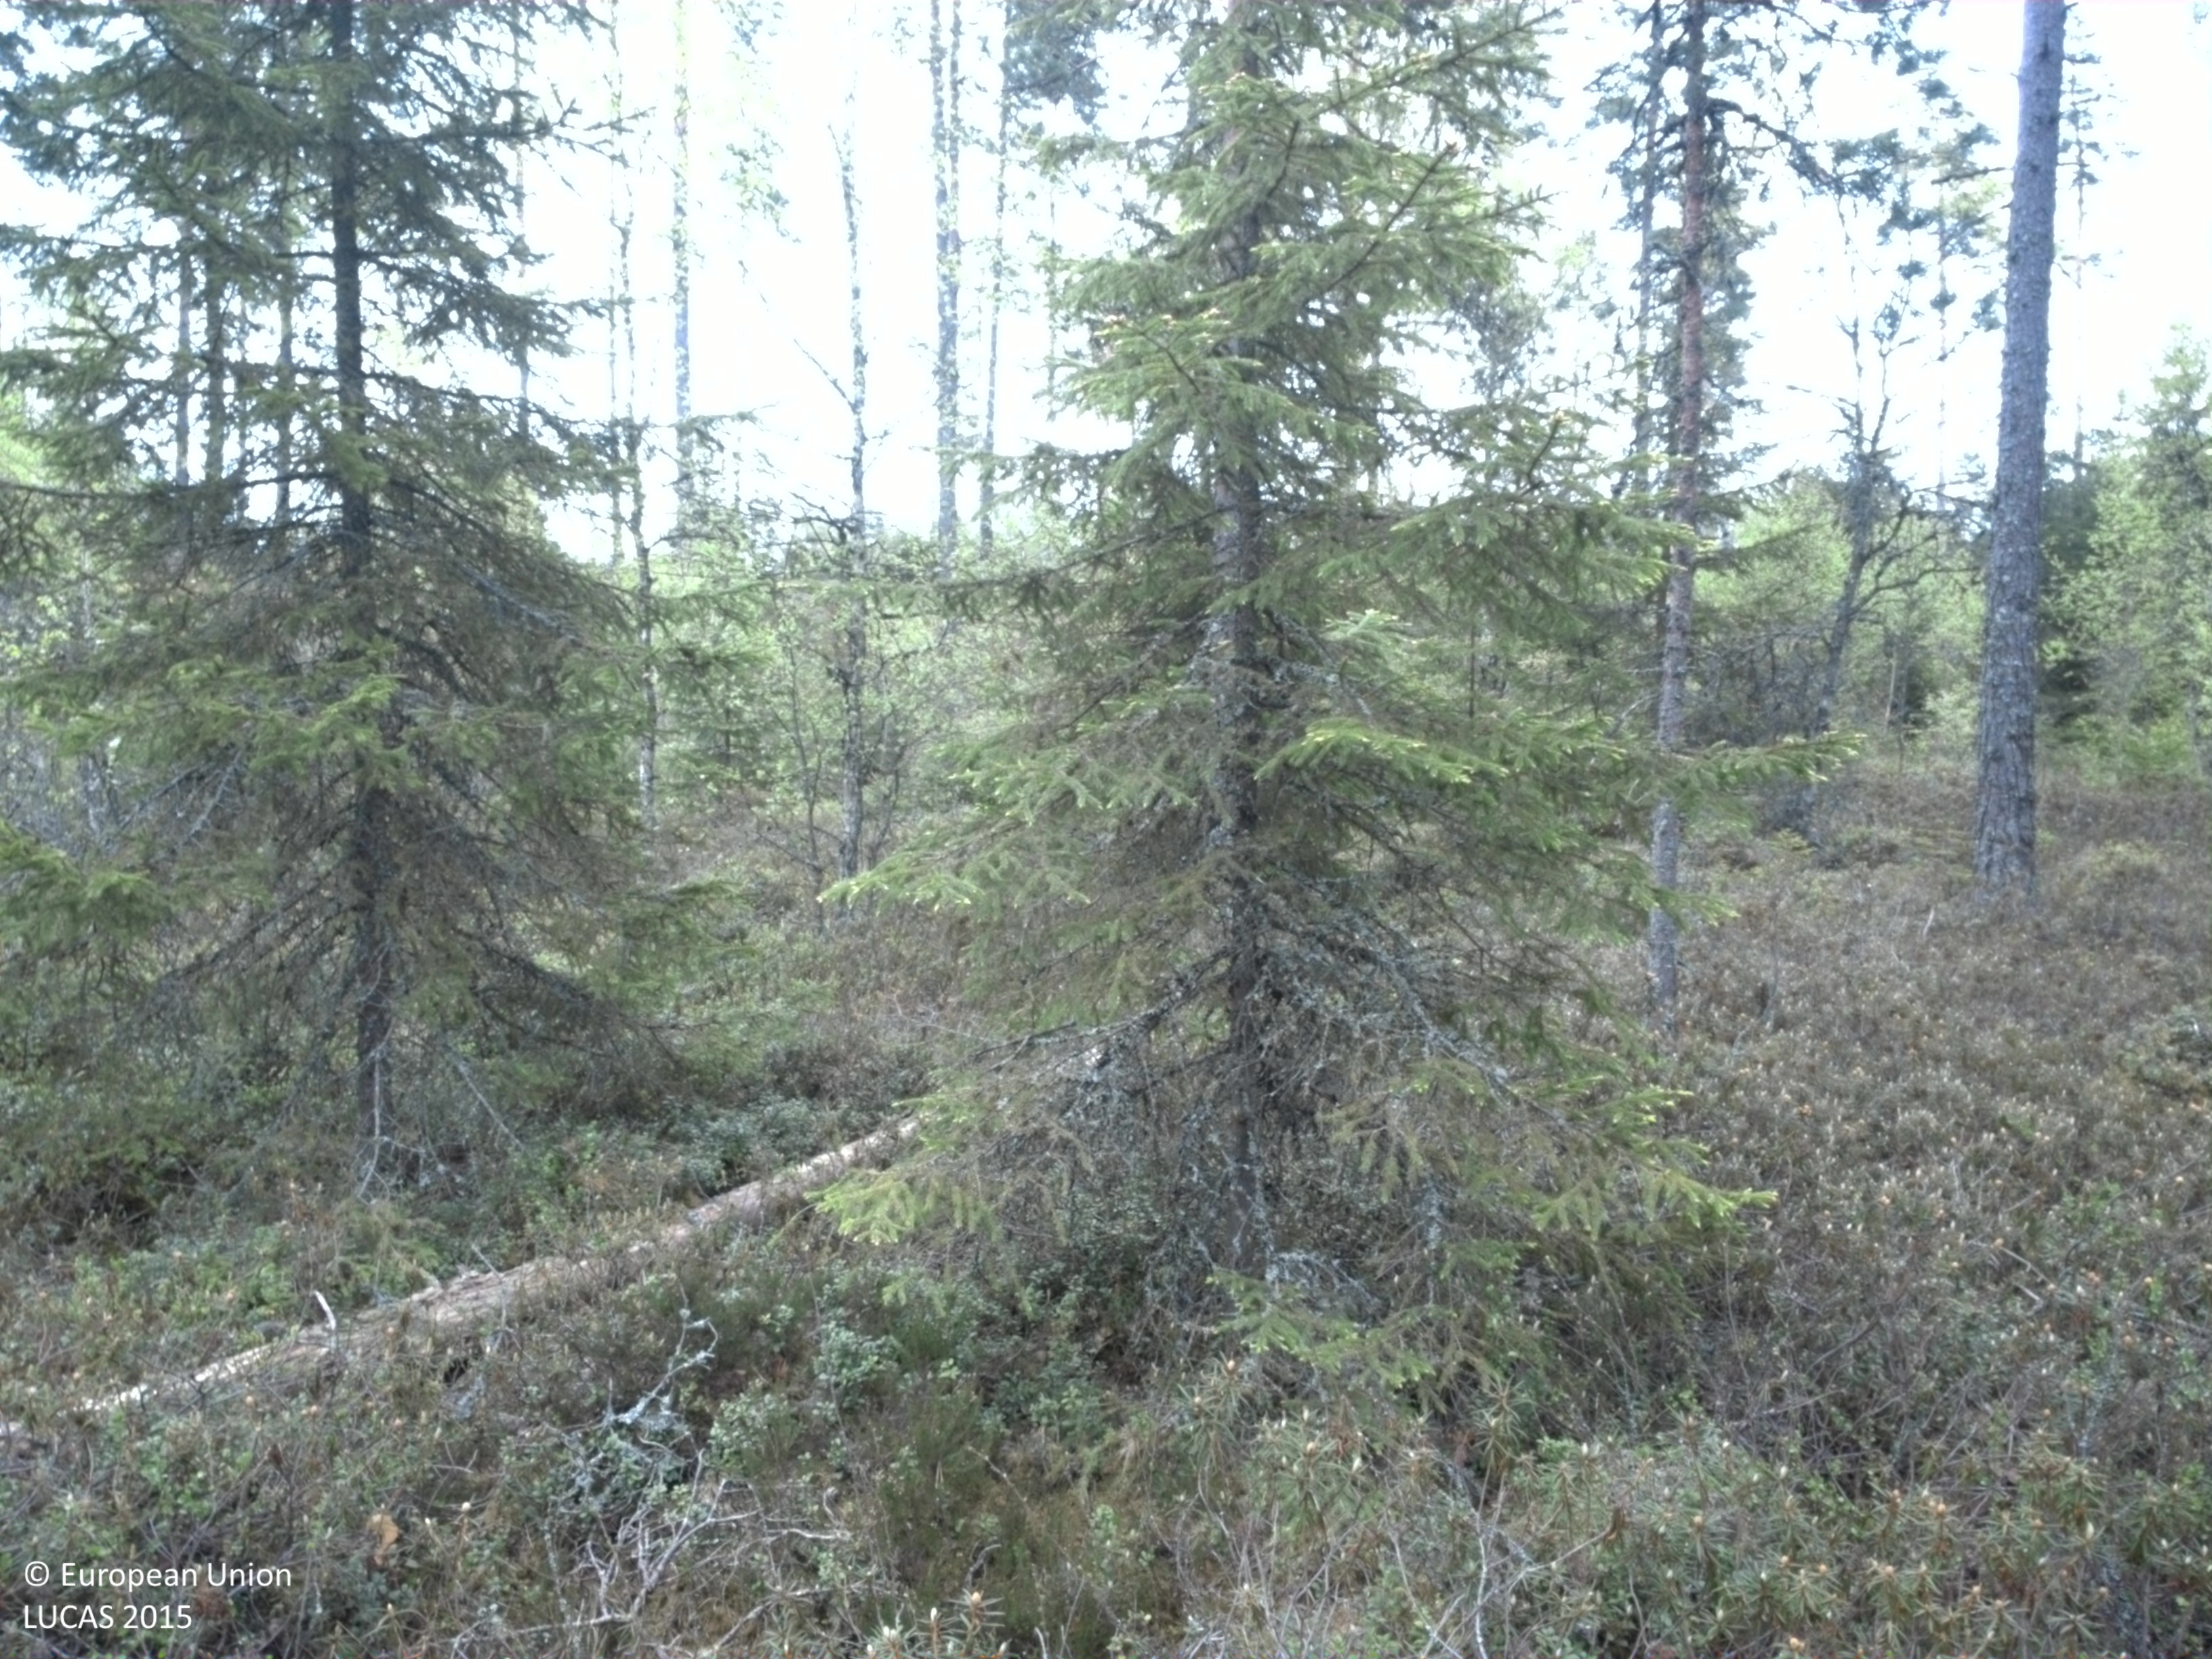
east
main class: Woodland
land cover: Pine dominated coniferous woodland
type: boreal forest
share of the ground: 50 - 75 %
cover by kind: coniferous forest trees 50 %, shrubs 25 %, lichens and mosses 20 %, broadleaved forest trees 5 %
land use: Forestry
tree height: > 5 m
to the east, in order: Pine dominated coniferous woodland; Spruce dominated mixed woodland; Pine dominated coniferous woodland; Paved roads, cycling and walking lanes; Broadleaved woodland; Spruce dominated mixed woodland; Spruce dominated coniferous woodland; Ditches and canals; Spruce dominated coniferous woodland; Pine dominated mixed woodland; Ditches and canals; Tracks
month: May
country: SE
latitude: 56.9688
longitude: 15.1130
